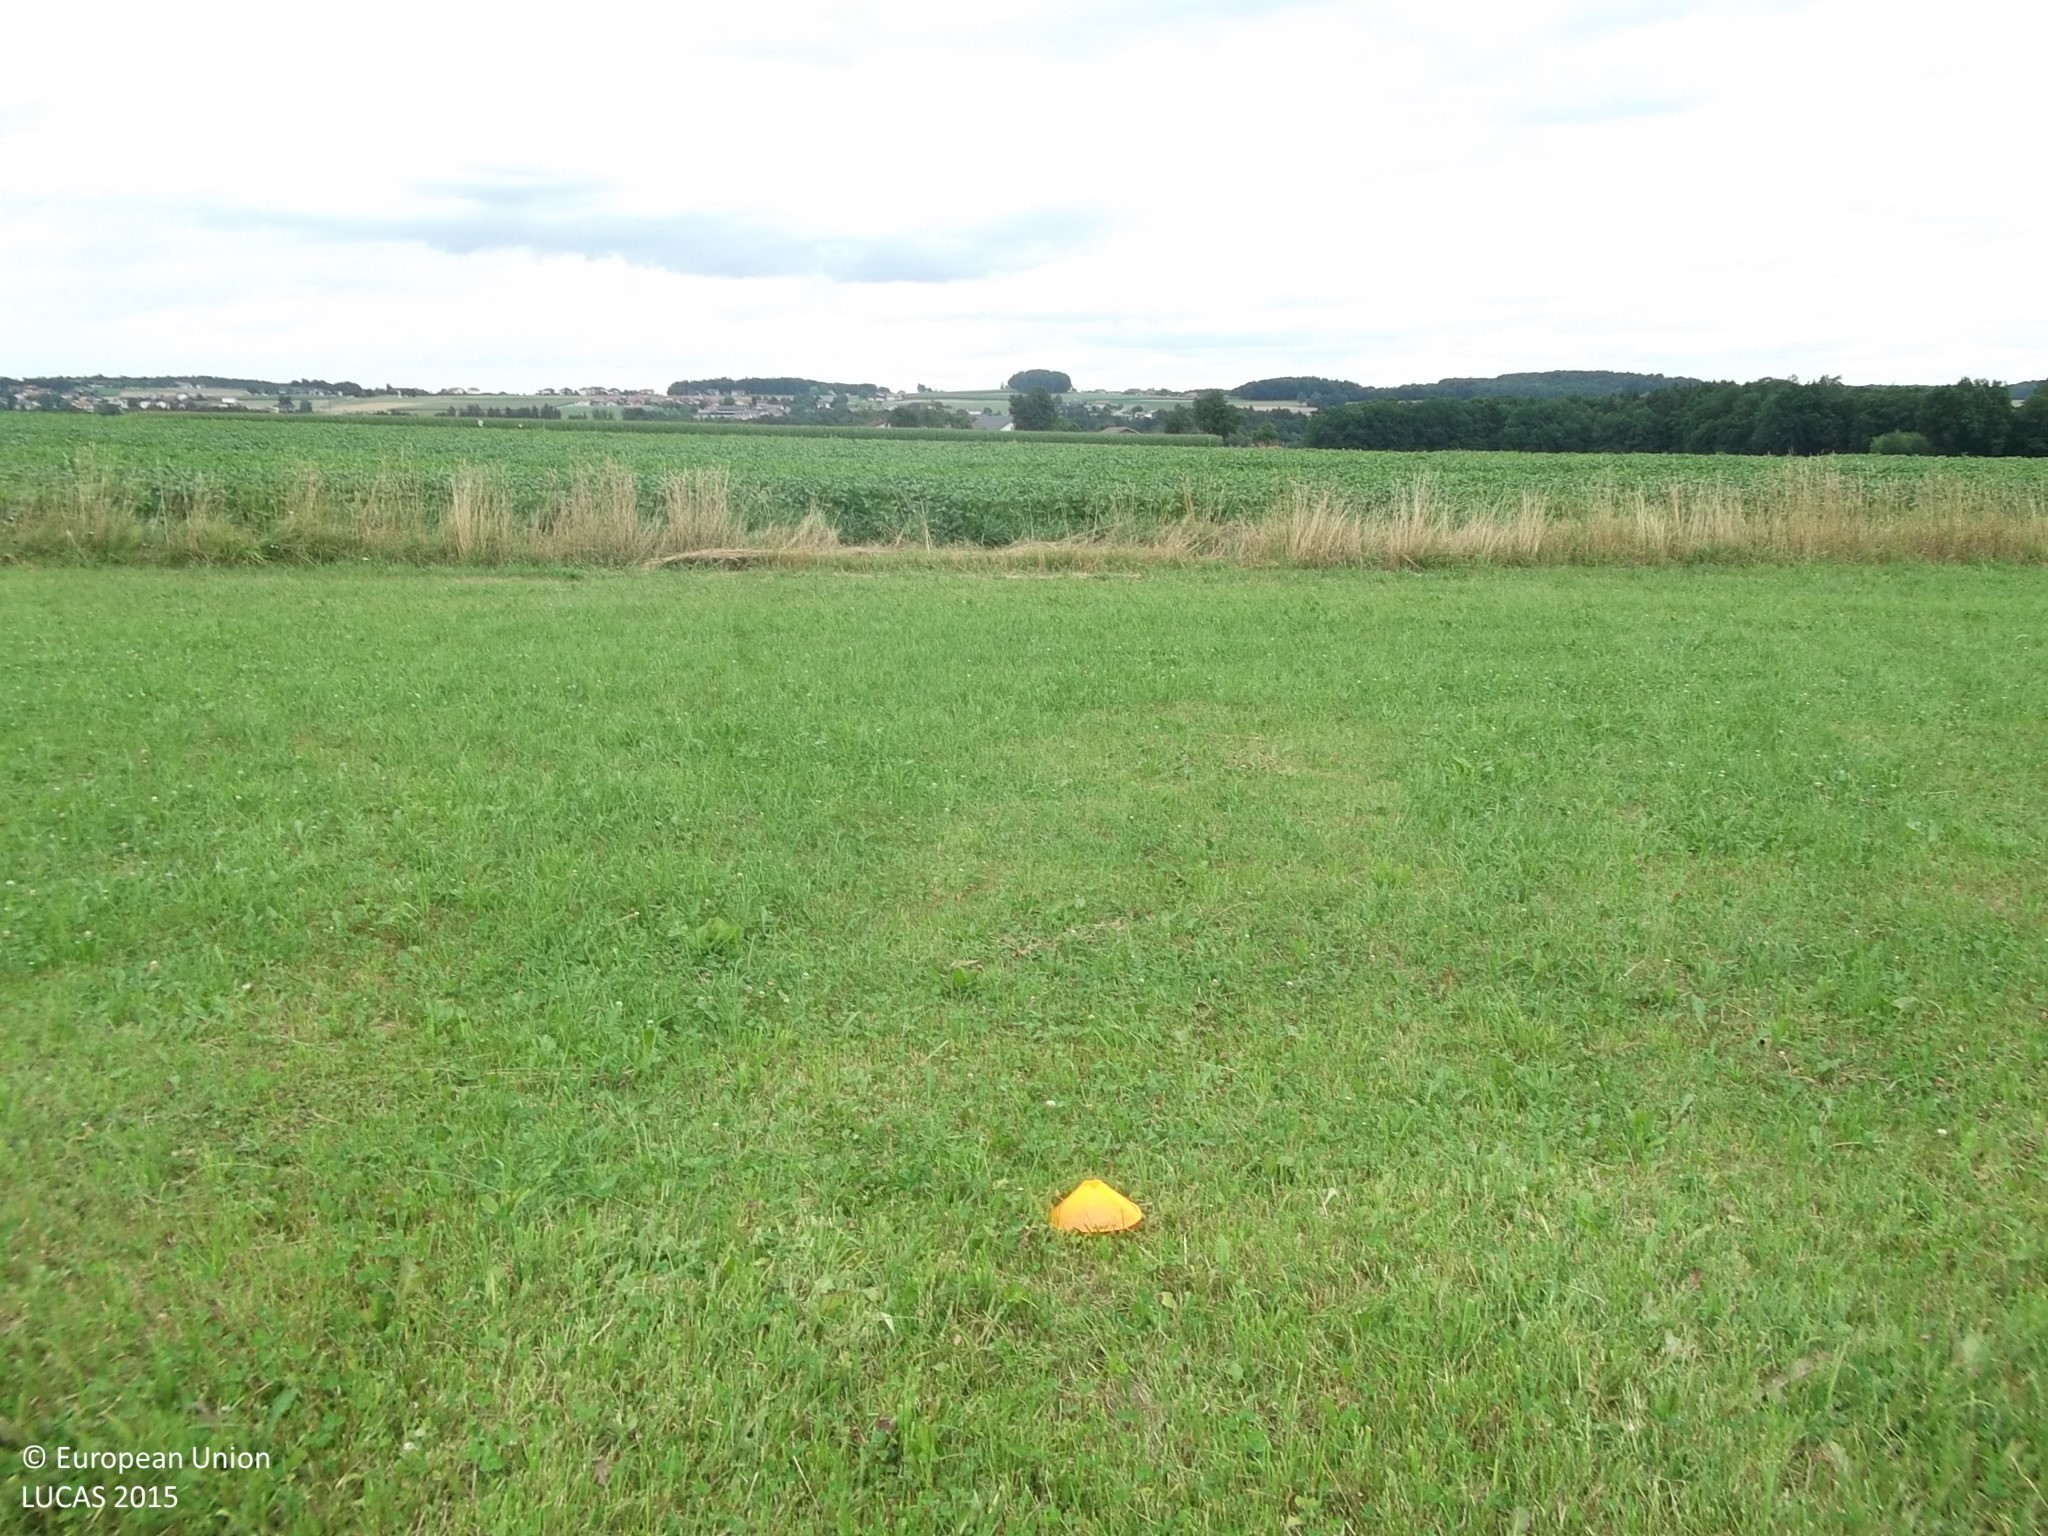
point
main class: Grassland
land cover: Grassland without tree/shrub cover
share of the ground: > 75 %
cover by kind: herbaceous plants 100 %
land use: Agriculture (excluding fallow land and kitchen gardens)
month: July
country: AT
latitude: 48.0619
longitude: 12.8033
